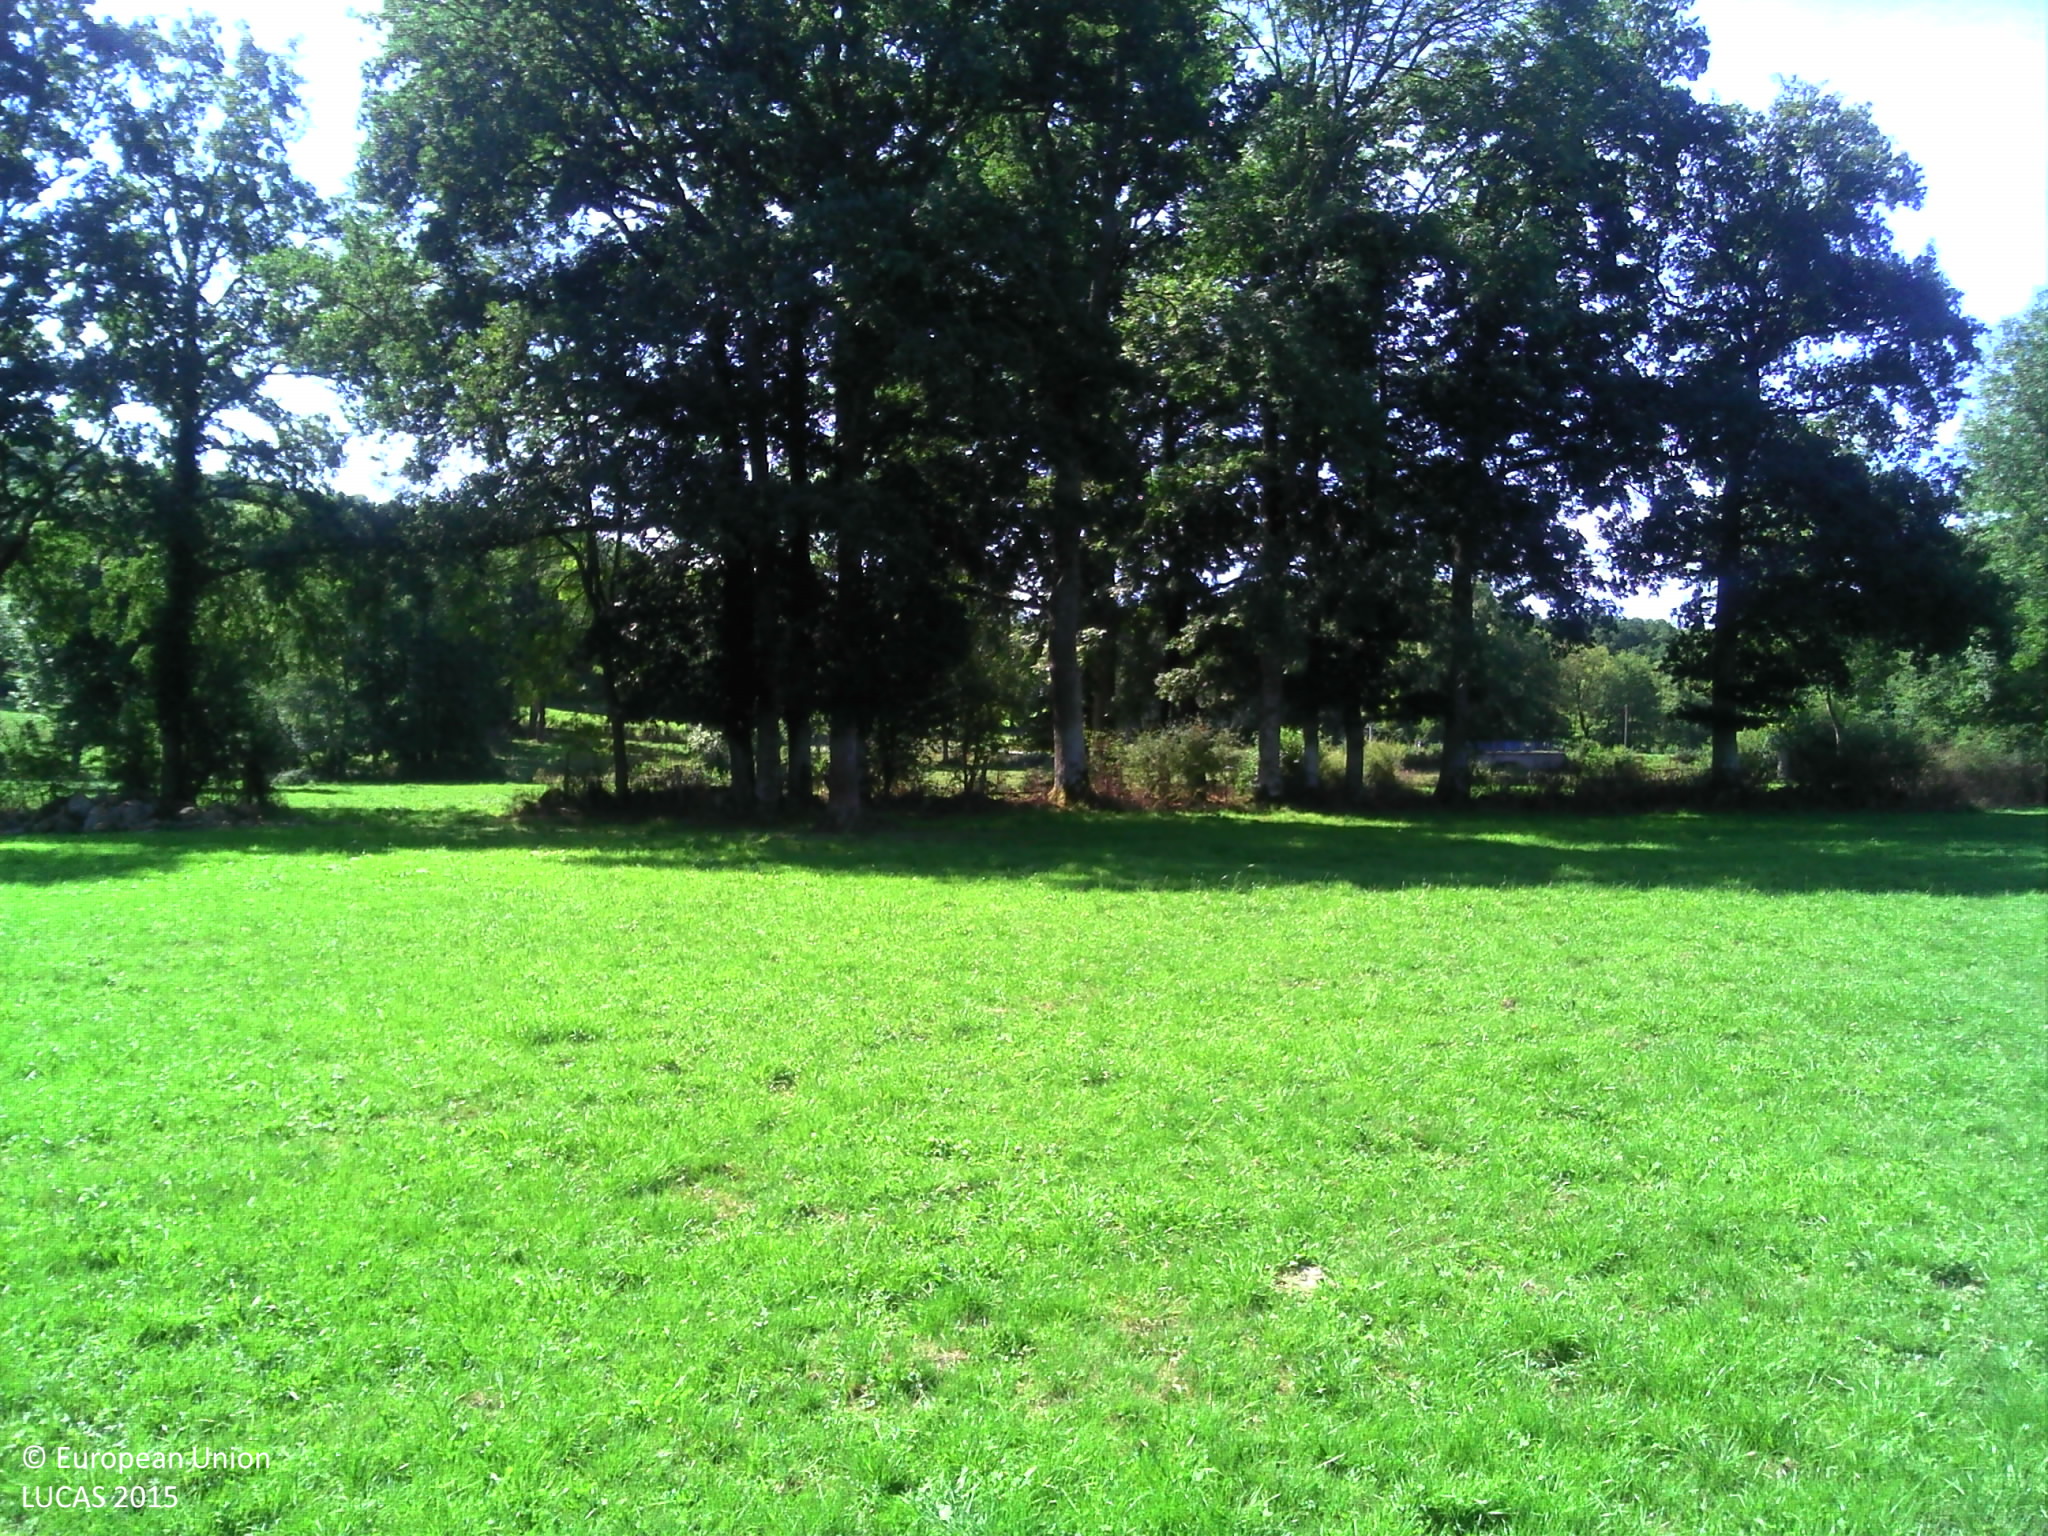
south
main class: Grassland
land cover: Grassland without tree/shrub cover
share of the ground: > 75 %
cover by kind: herbaceous plants 100 %
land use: Agriculture (excluding fallow land and kitchen gardens)
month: August
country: FR
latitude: 45.9464
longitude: 2.2947
